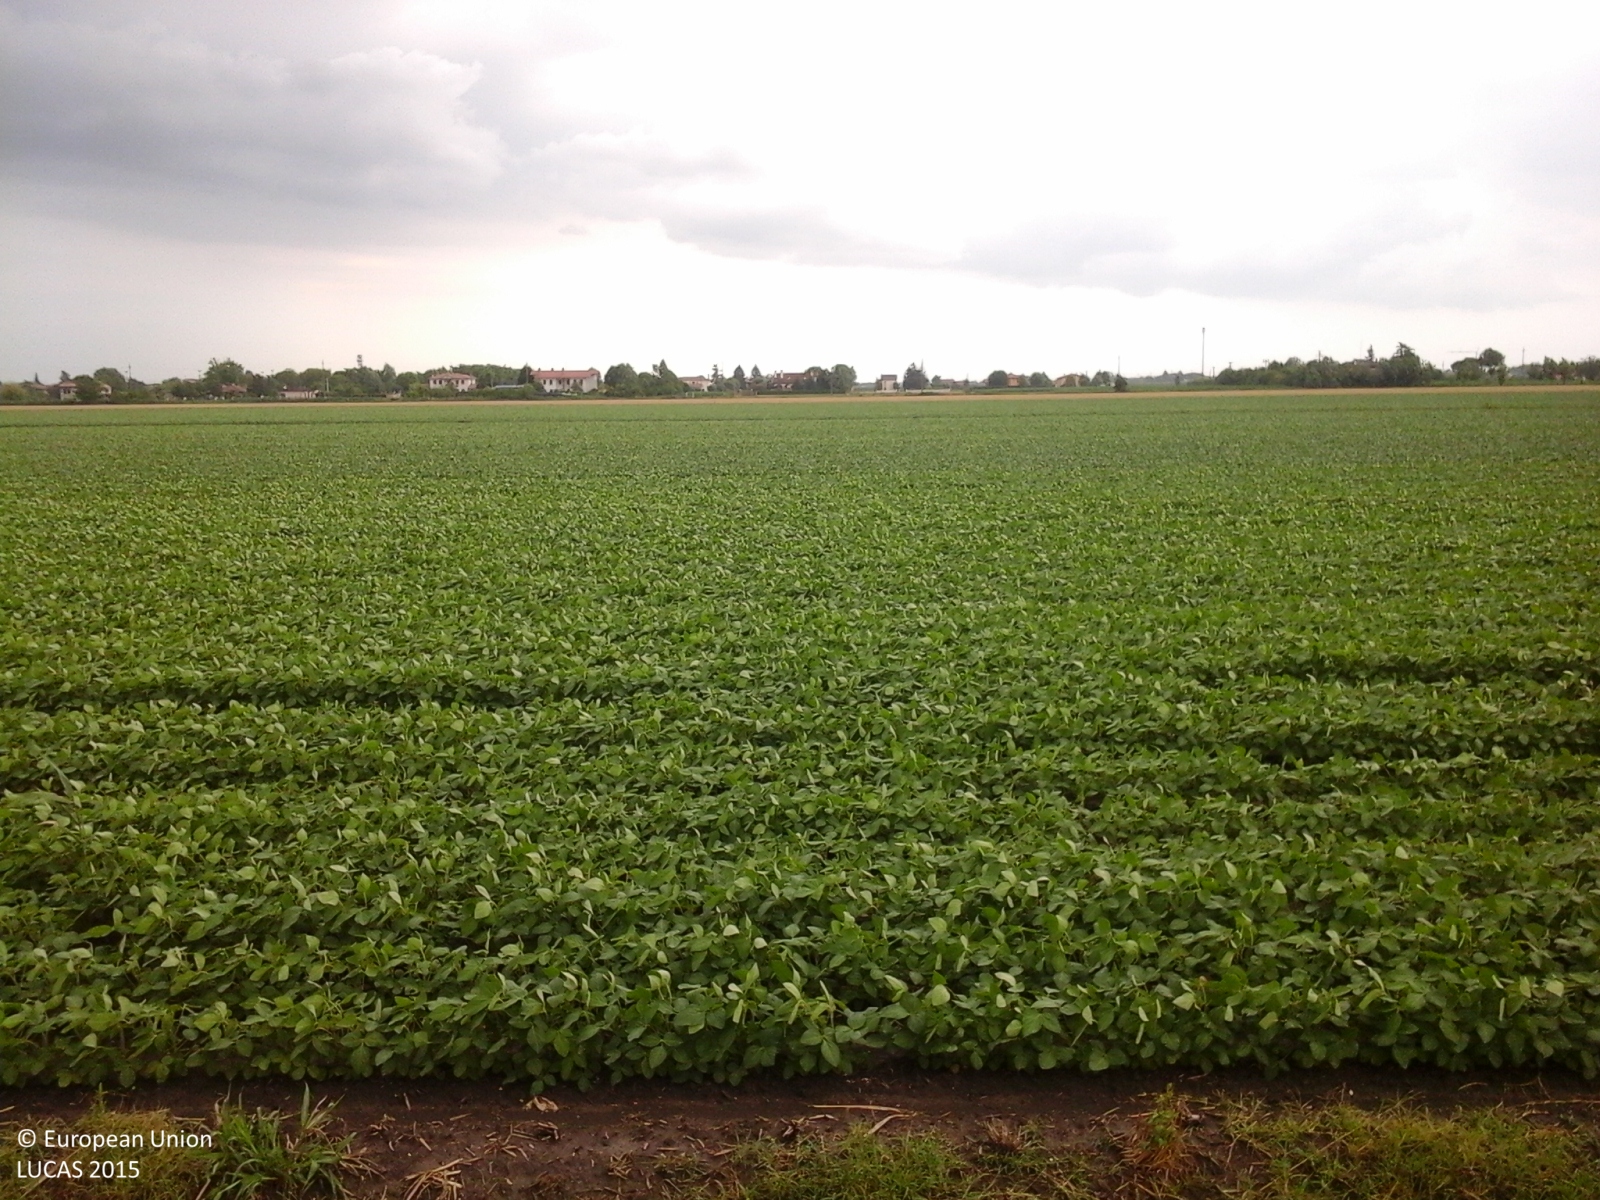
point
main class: Cropland
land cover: Soya
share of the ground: > 75 %
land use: Agriculture (excluding fallow land and kitchen gardens)
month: June
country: IT
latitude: 45.6328
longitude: 12.6772
